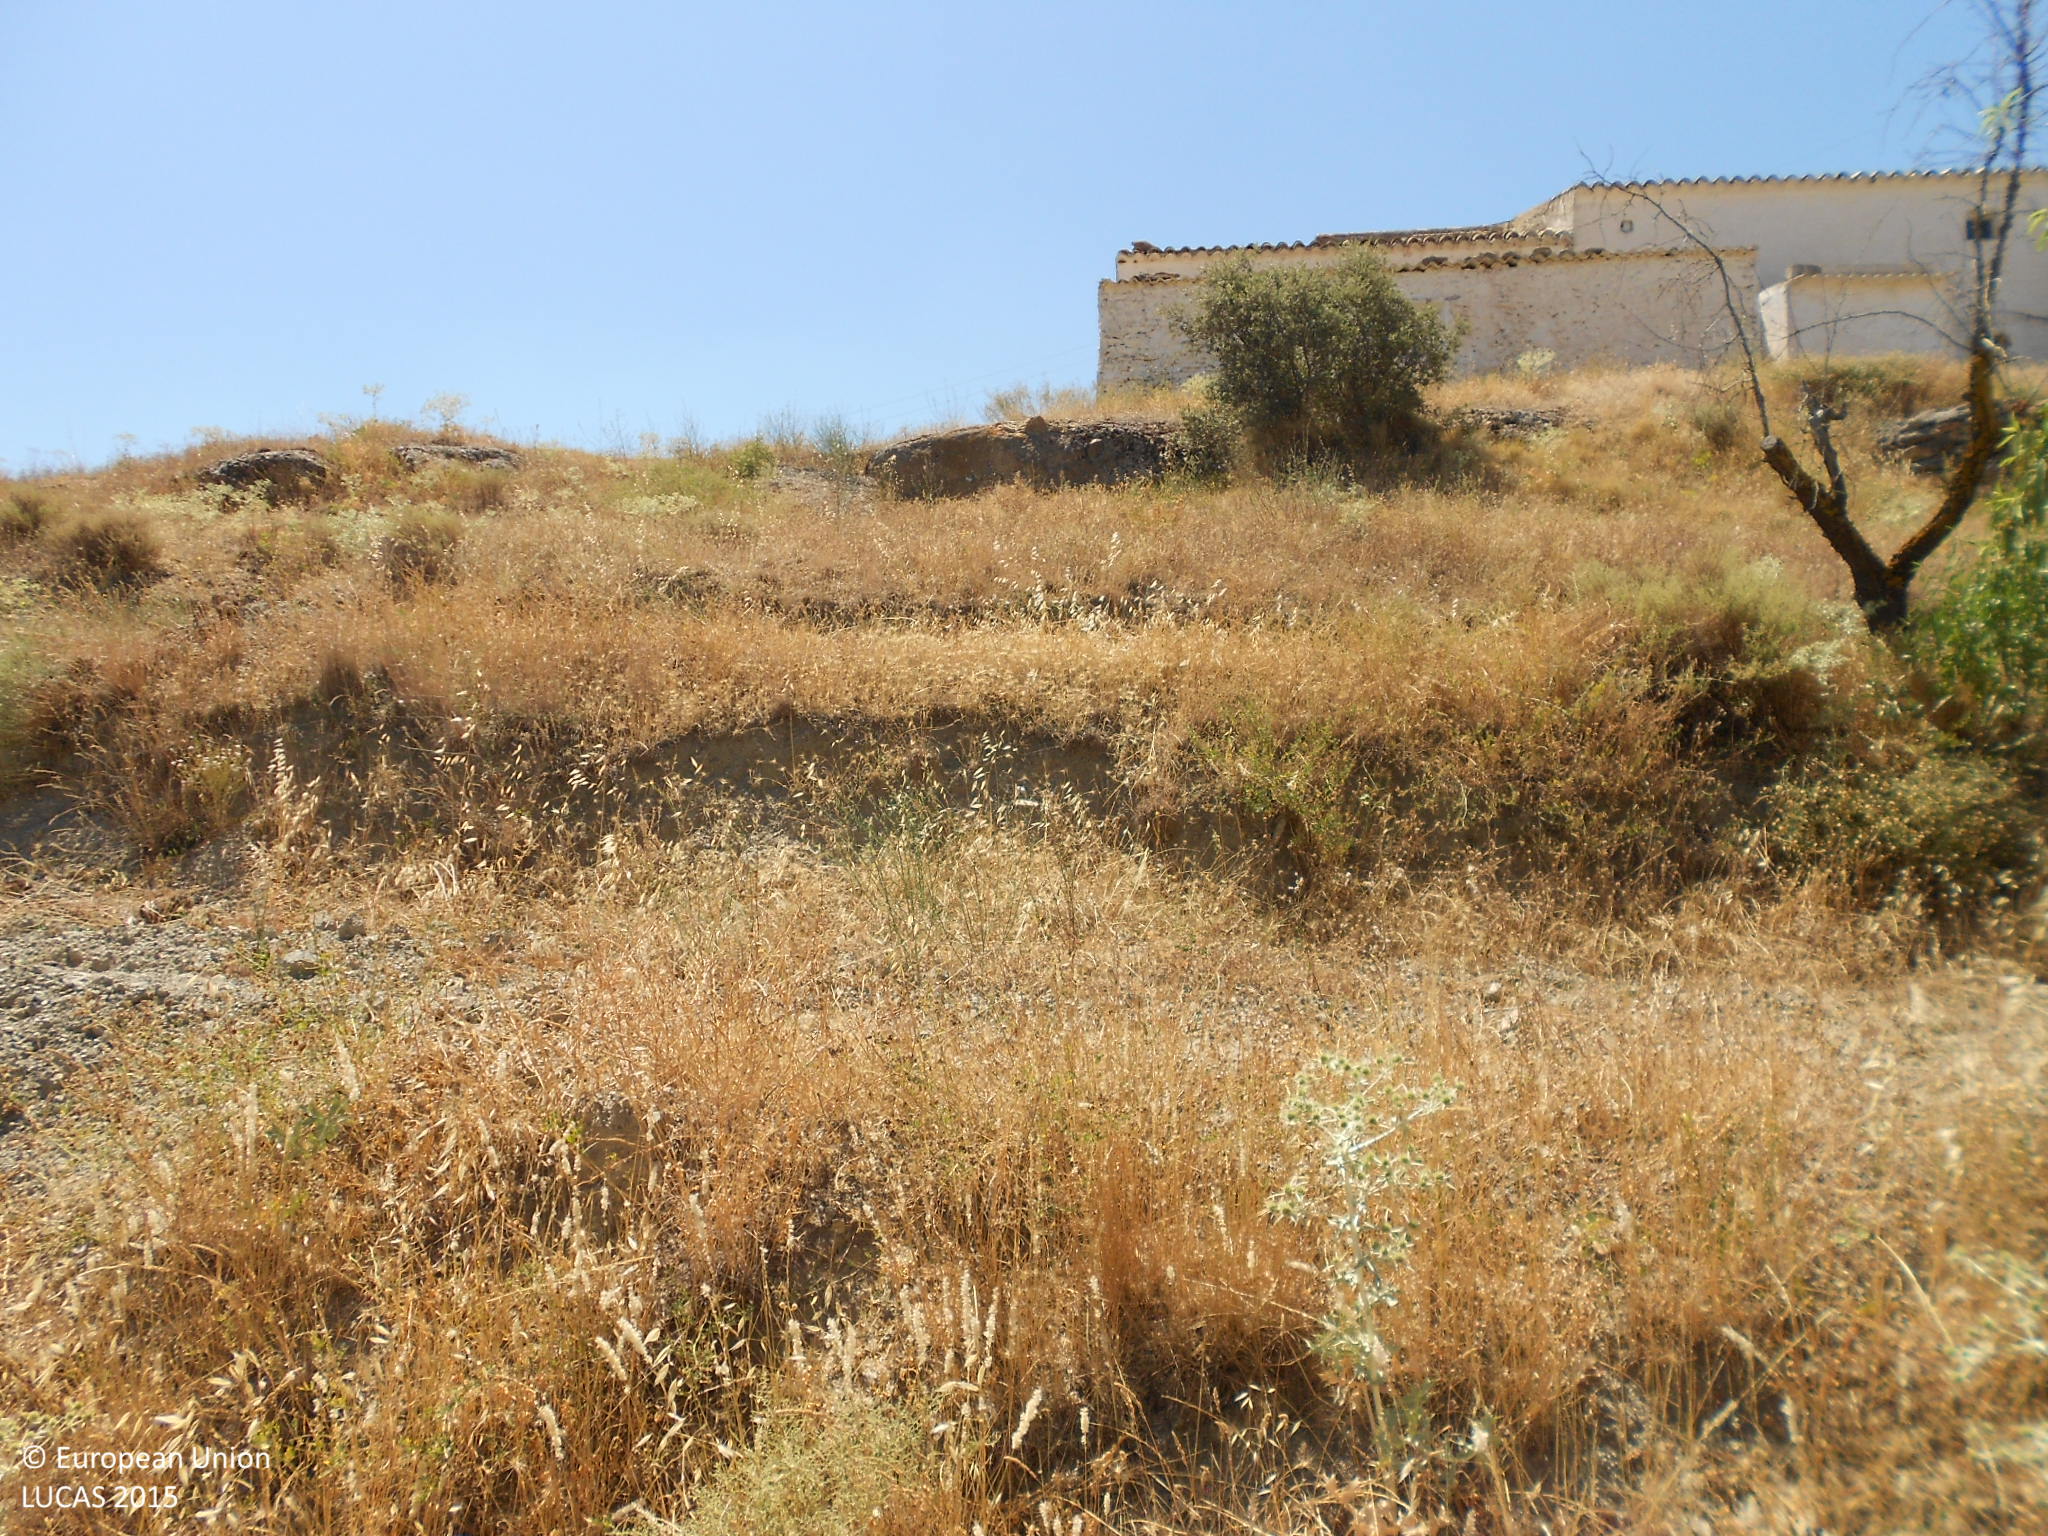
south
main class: Cropland
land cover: Nuts trees
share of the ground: 25 - 50 %
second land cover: Spontaneously vegetated surfaces
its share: 10 - 25 %
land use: Agriculture (excluding fallow land and kitchen gardens)
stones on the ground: > 50 %
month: July
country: ES
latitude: 37.5964
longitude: -2.2282
